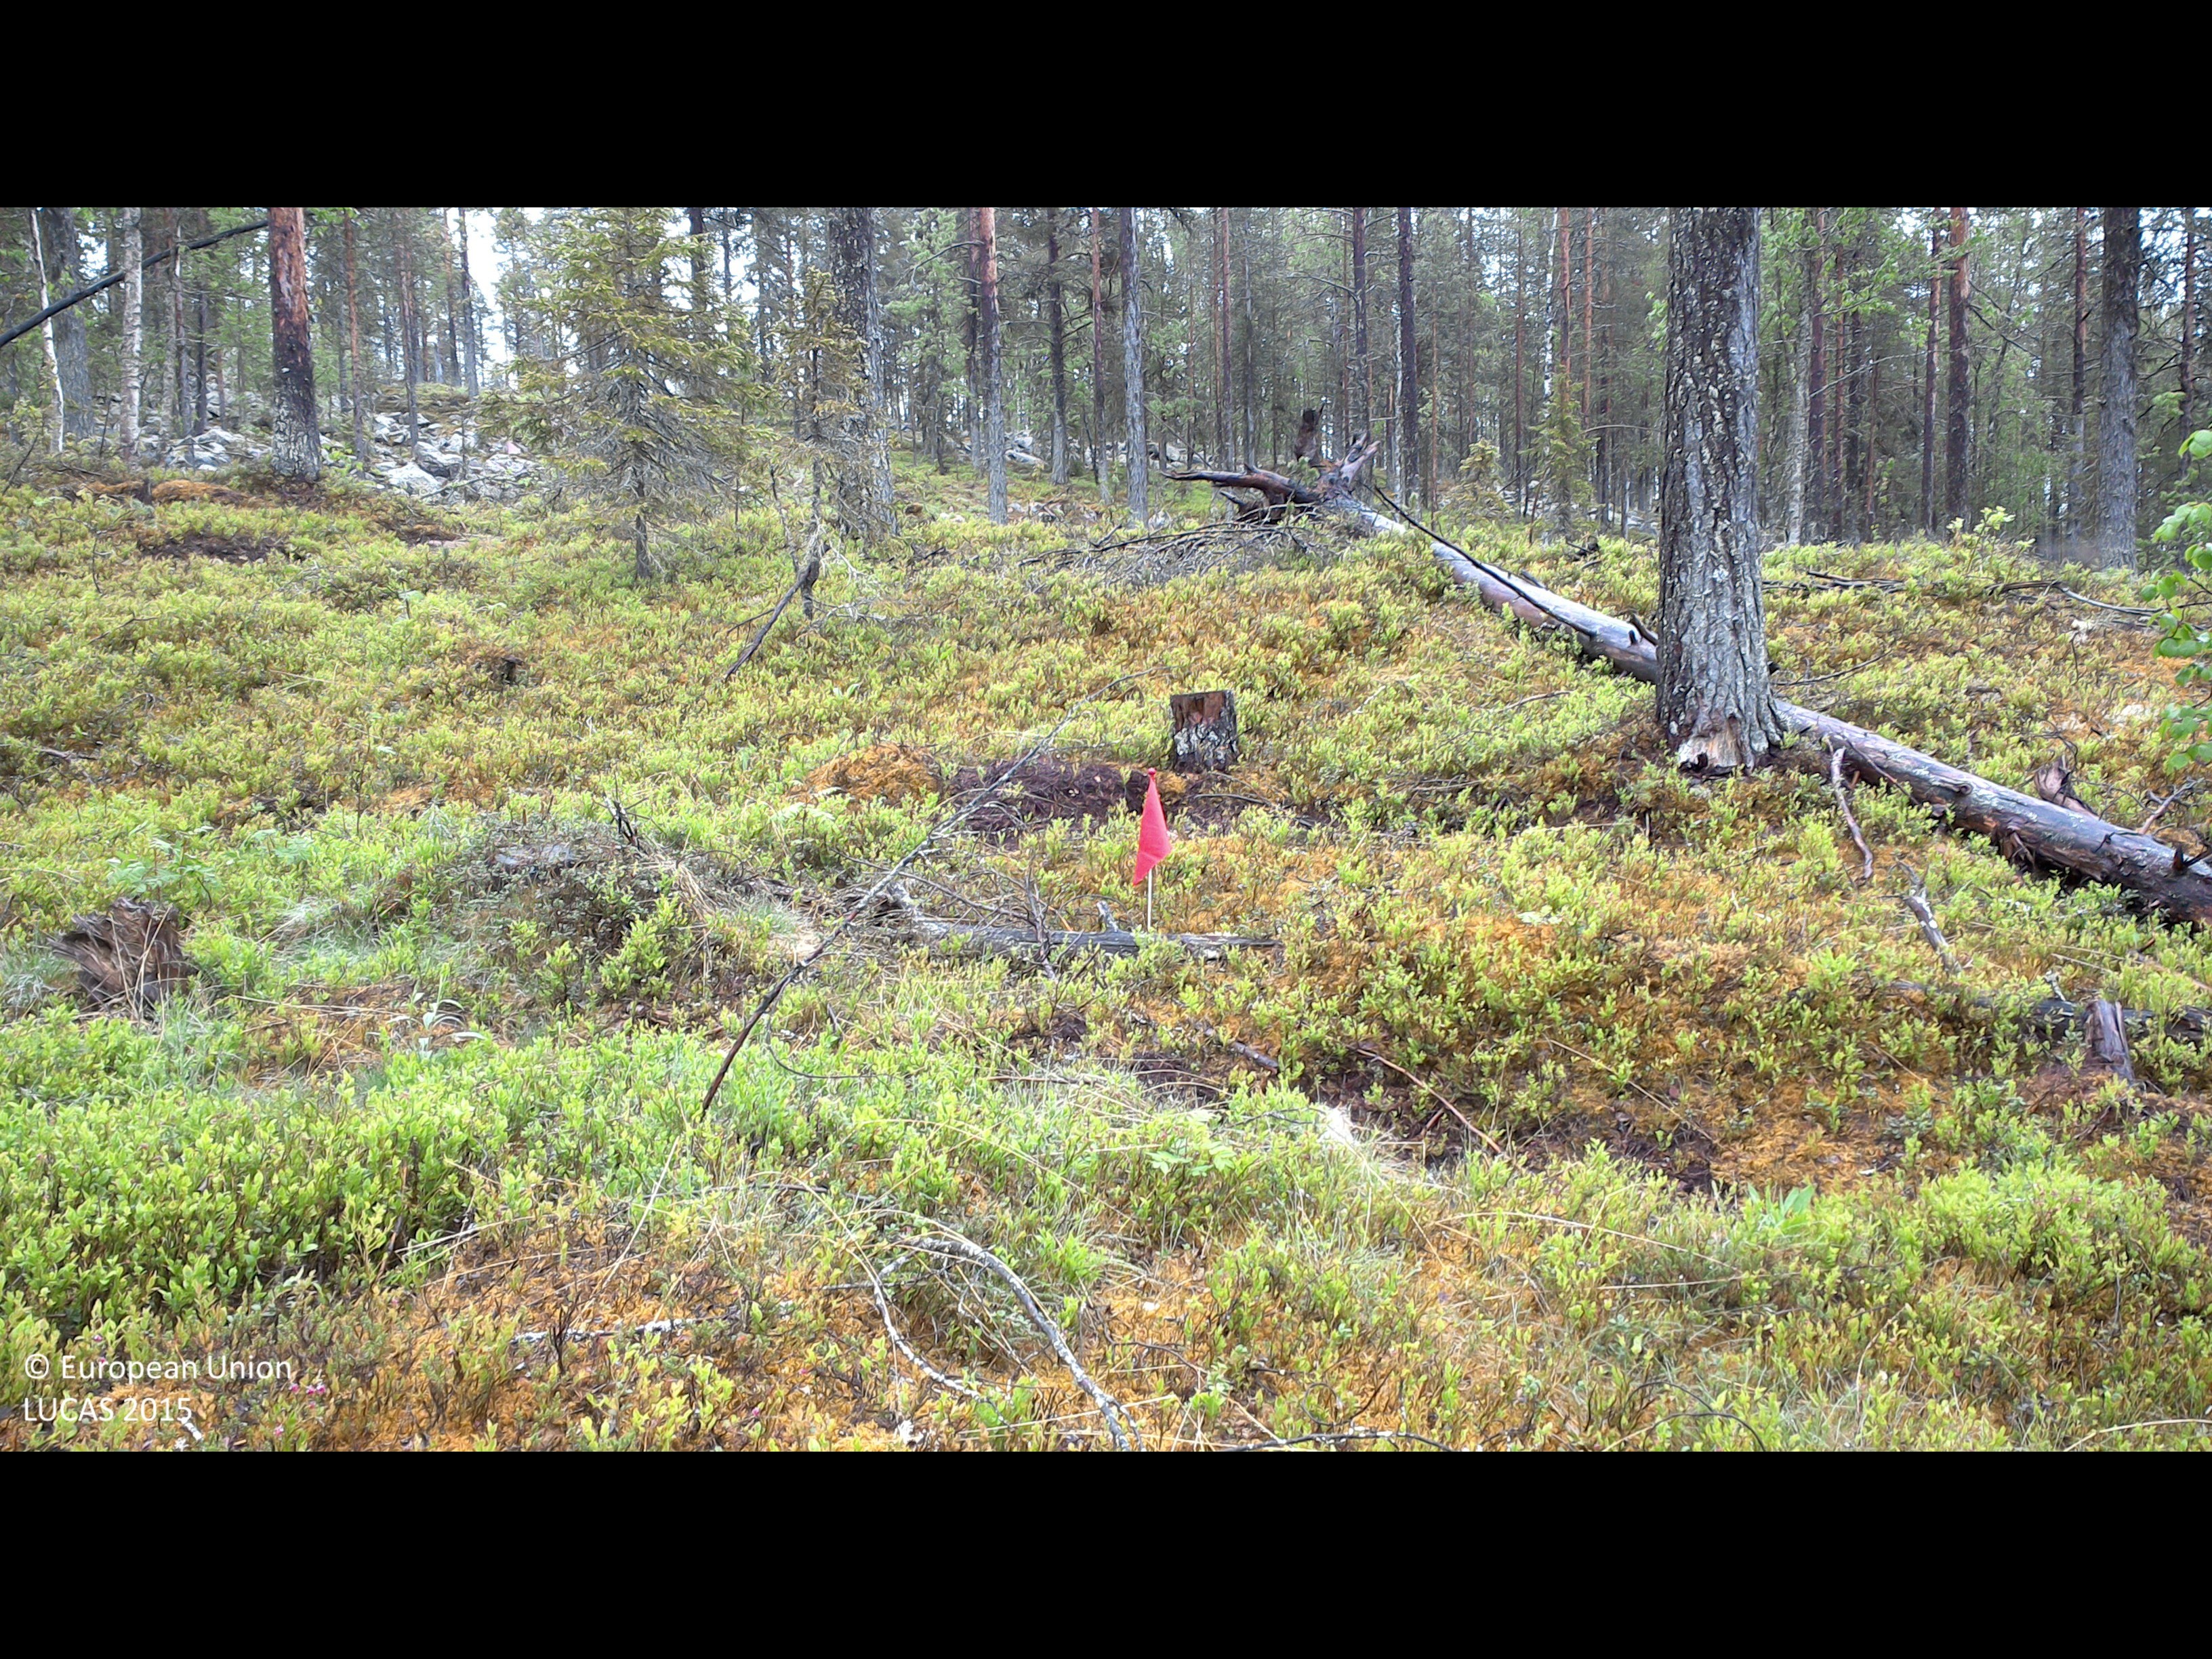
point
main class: Woodland
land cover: Pine dominated coniferous woodland
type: boreal forest
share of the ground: 10 - 25 %
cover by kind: shrubs 65 %, coniferous forest trees 20 %, lichens and mosses 10 %, unconsolidated bare surface 5 %
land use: Forestry
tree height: > 5 m
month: June
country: SE
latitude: 67.0211
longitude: 22.0111
